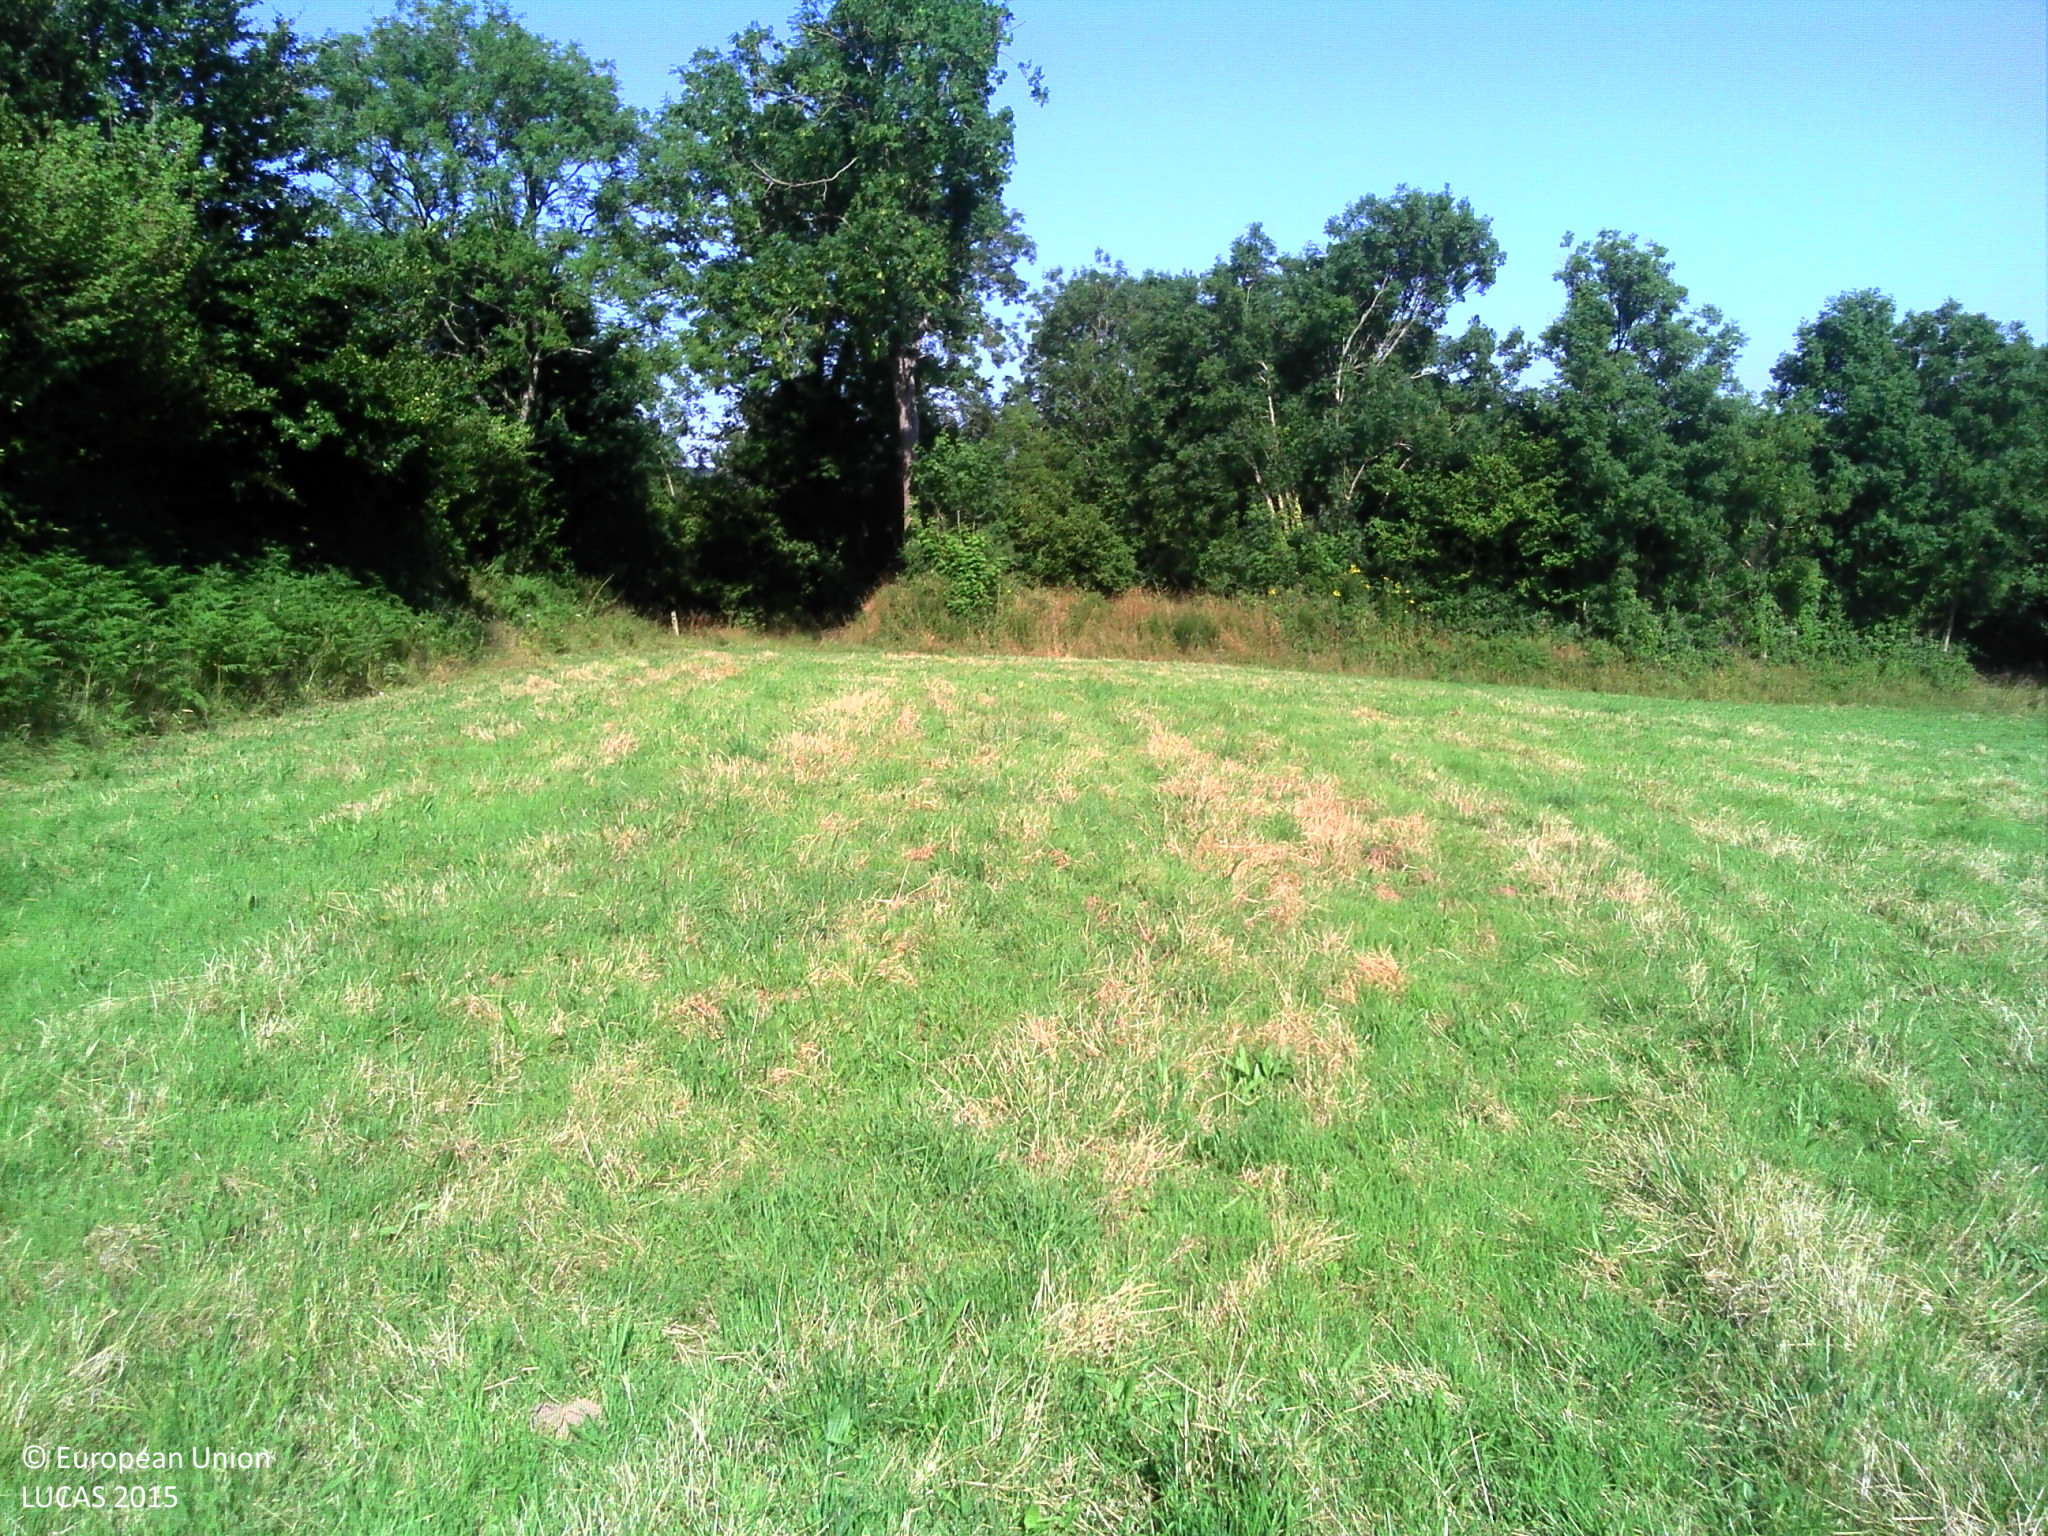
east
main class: Grassland
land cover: Grassland without tree/shrub cover
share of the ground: > 75 %
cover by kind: herbaceous plants 100 %
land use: Agriculture (excluding fallow land and kitchen gardens)
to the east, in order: Grassland without tree/shrub cover; Broadleaved woodland; Grassland without tree/shrub cover; Tracks; Broadleaved woodland; Grass margins; Maize; Abandoned hedges; Grassland without tree/shrub cover; Broadleaved woodland; Tracks; Broadleaved woodland; Grass margins; Fences; Grassland without tree/shrub cover
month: July
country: FR
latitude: 49.0211
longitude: -1.3000
